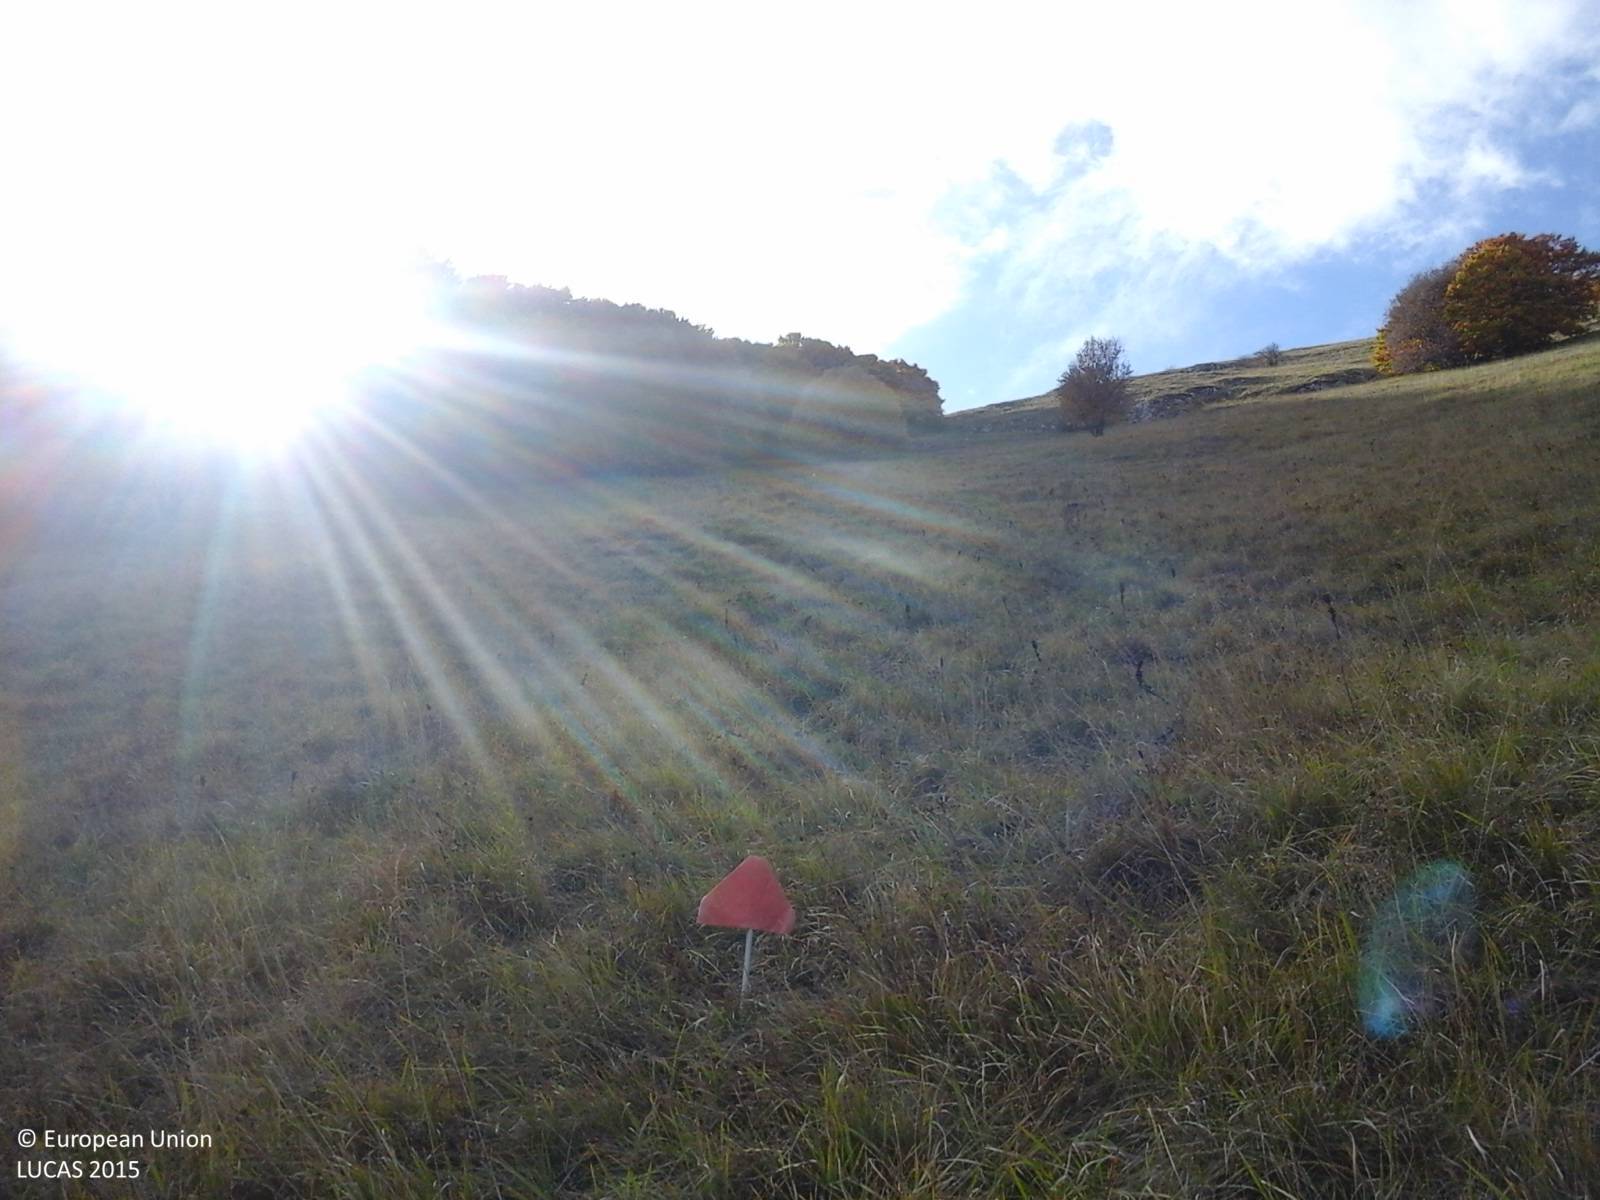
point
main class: Grassland
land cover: Grassland without tree/shrub cover
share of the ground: > 75 %
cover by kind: herbaceous plants 100 %
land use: Agriculture (excluding fallow land and kitchen gardens)
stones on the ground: < 10 %
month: October
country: IT
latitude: 42.7848
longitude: 13.1811
